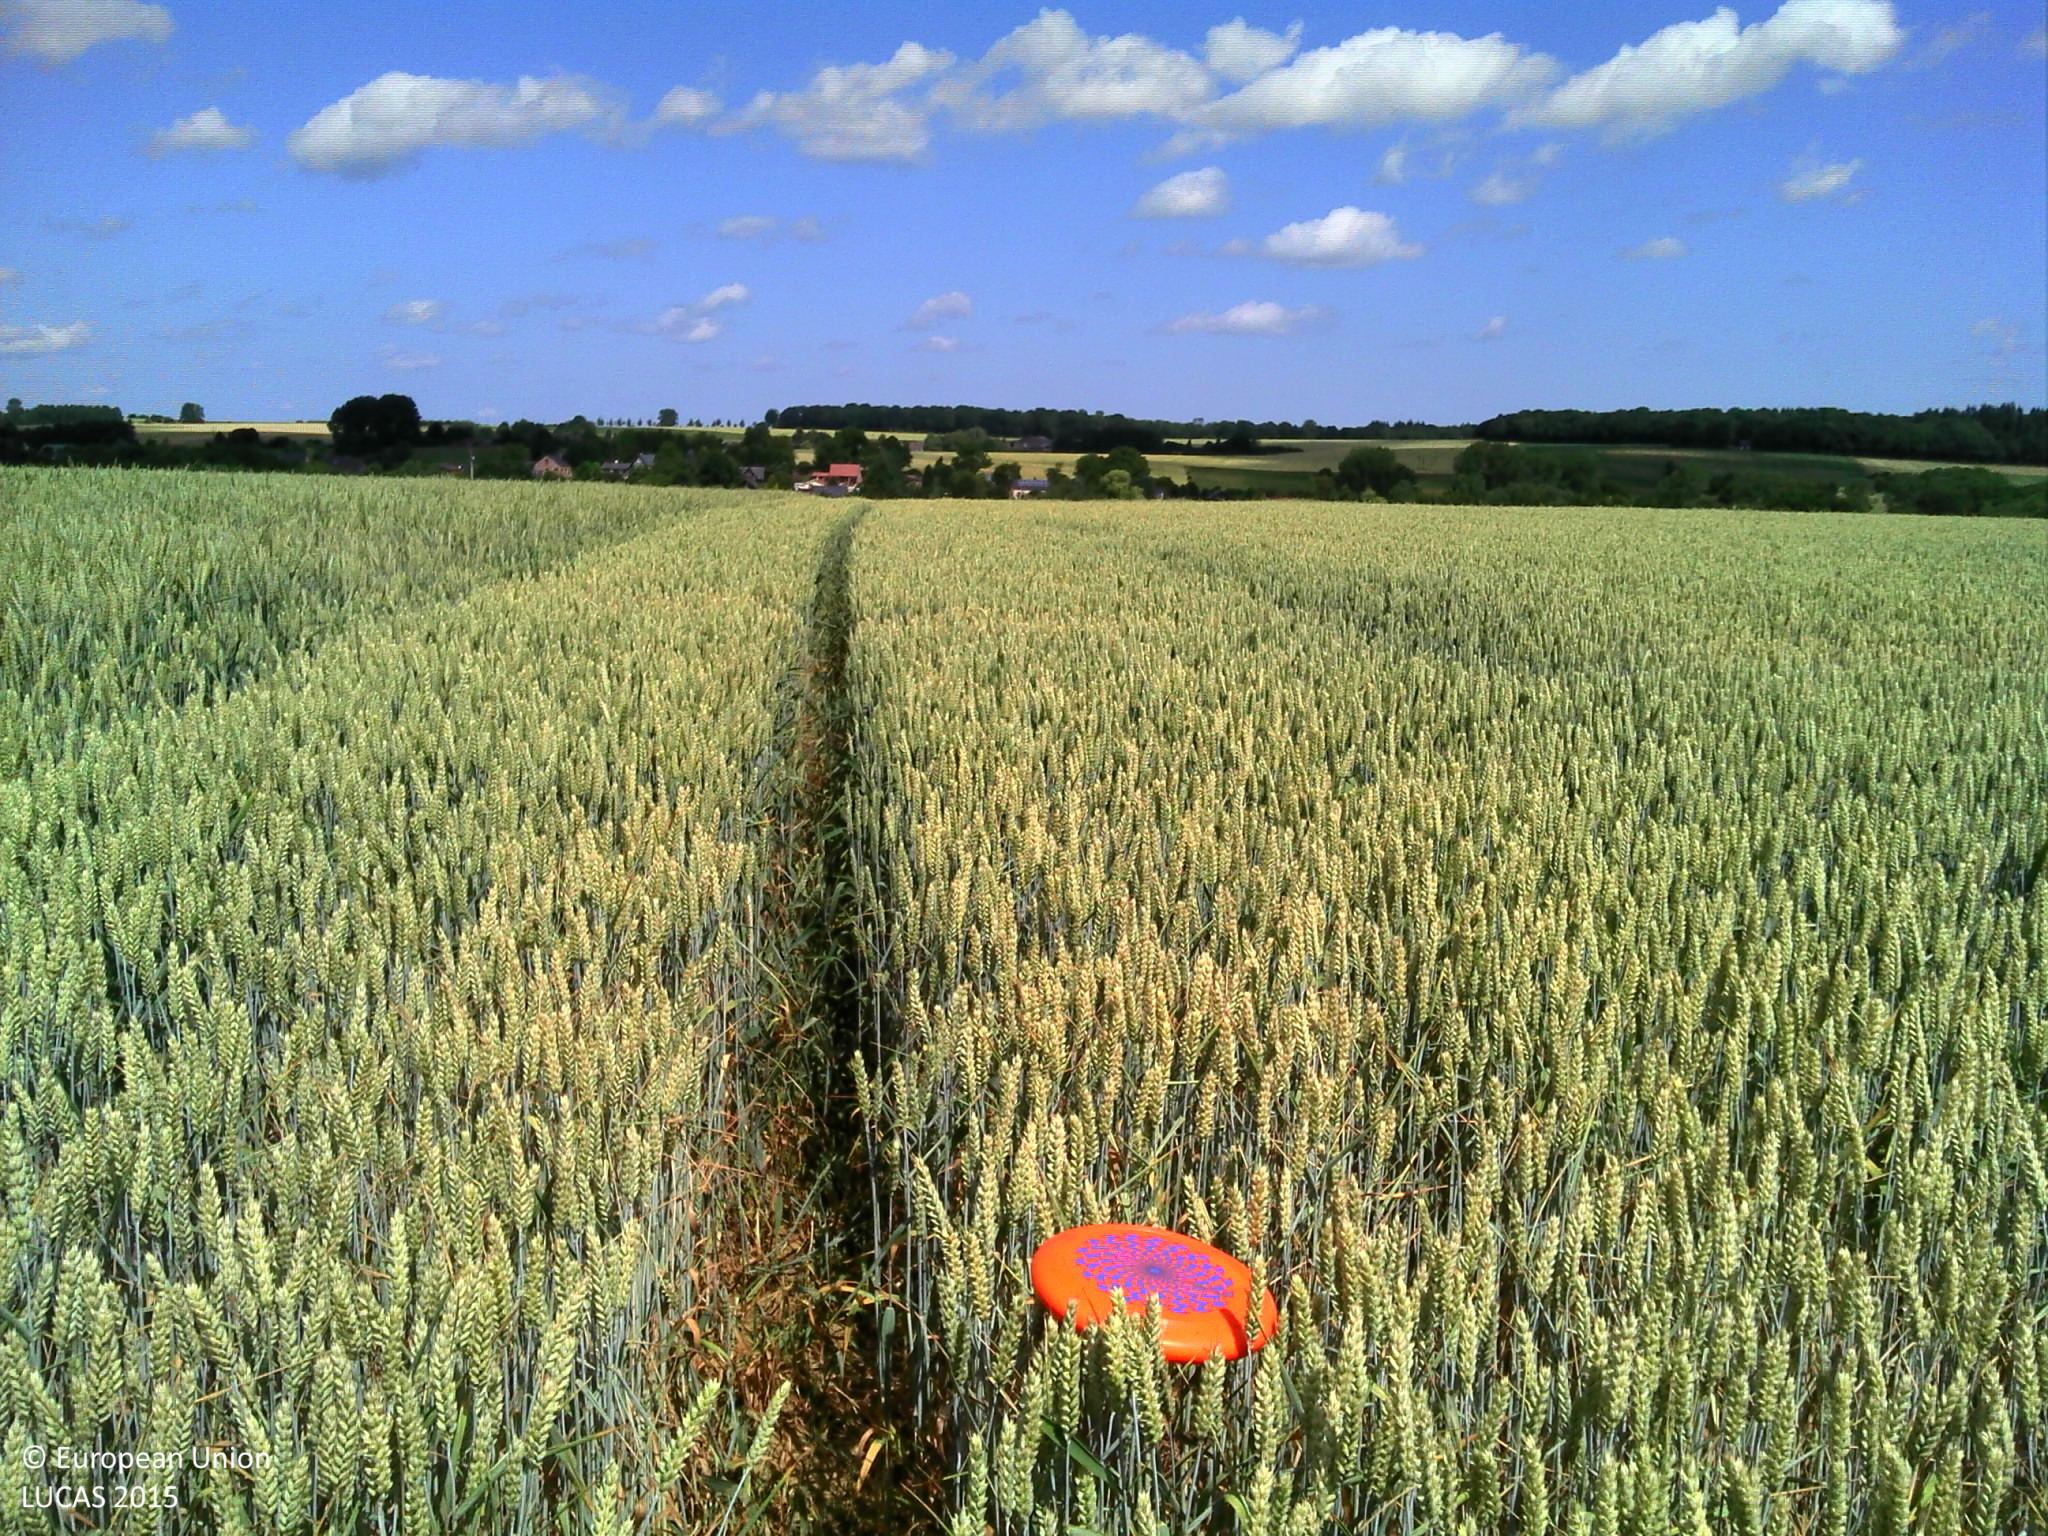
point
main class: Cropland
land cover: Common wheat
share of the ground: > 75 %
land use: Agriculture (excluding fallow land and kitchen gardens)
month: July
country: BE
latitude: 50.2338
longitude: 4.5425
